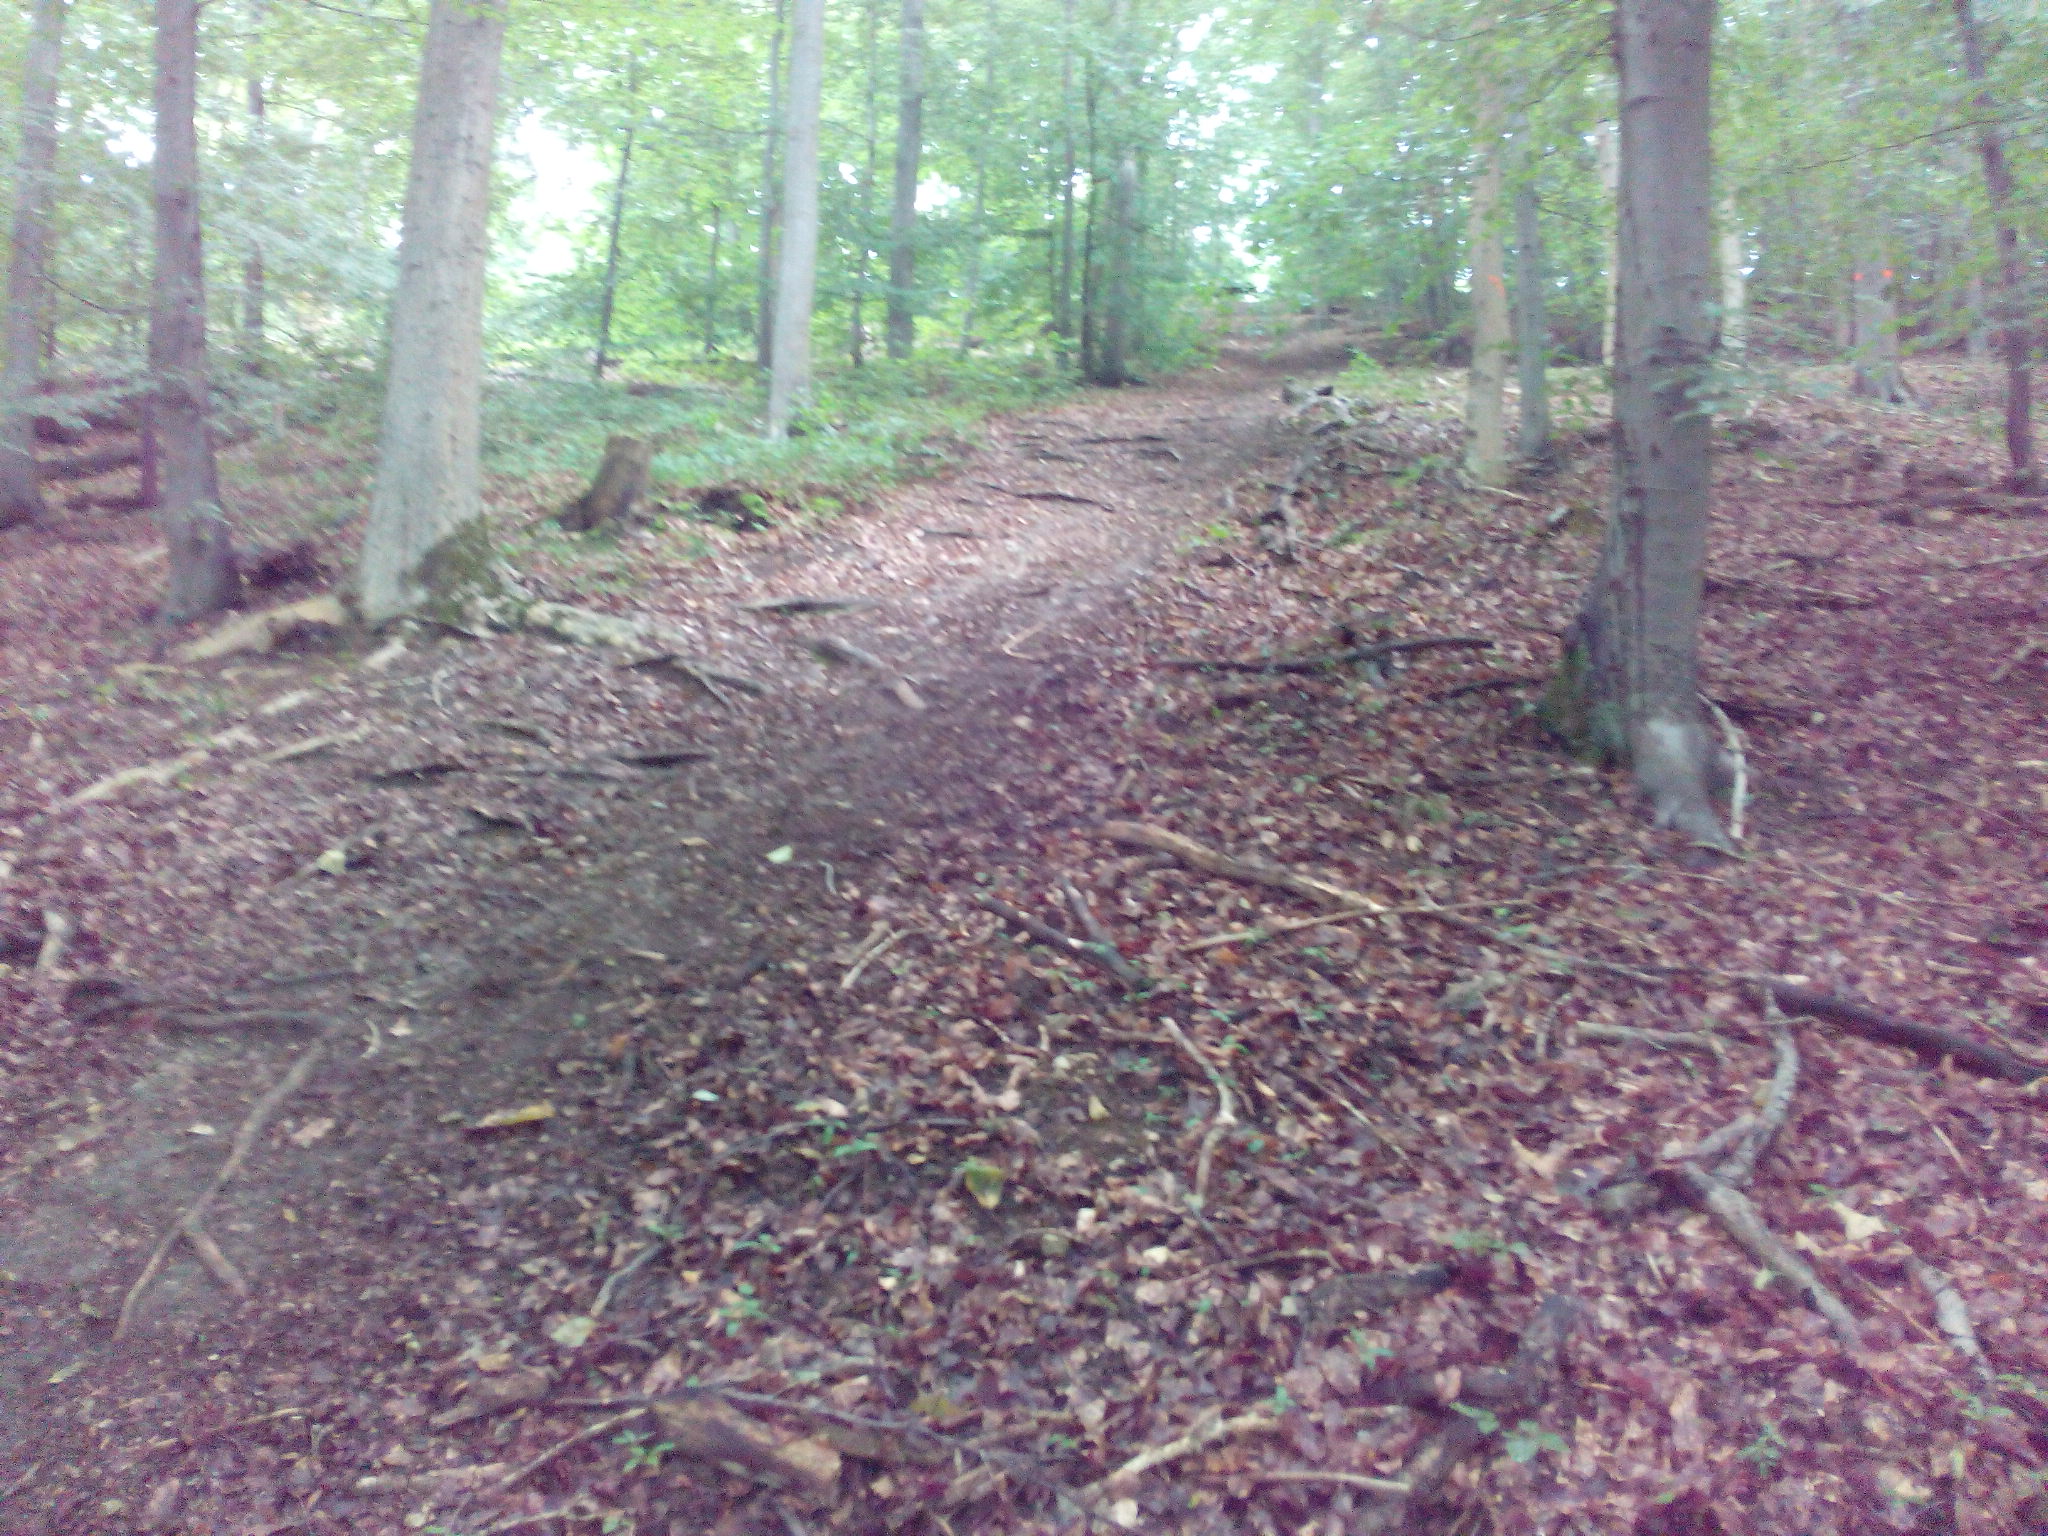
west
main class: Woodland
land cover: Broadleaved woodland
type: mesophytic deciduous forest
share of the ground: > 75 %
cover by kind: broadleaved forest trees 90 %, herbaceous plants 10 %
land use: Forestry
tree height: > 5 m
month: August
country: DE
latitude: 52.1437
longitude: 9.8977
